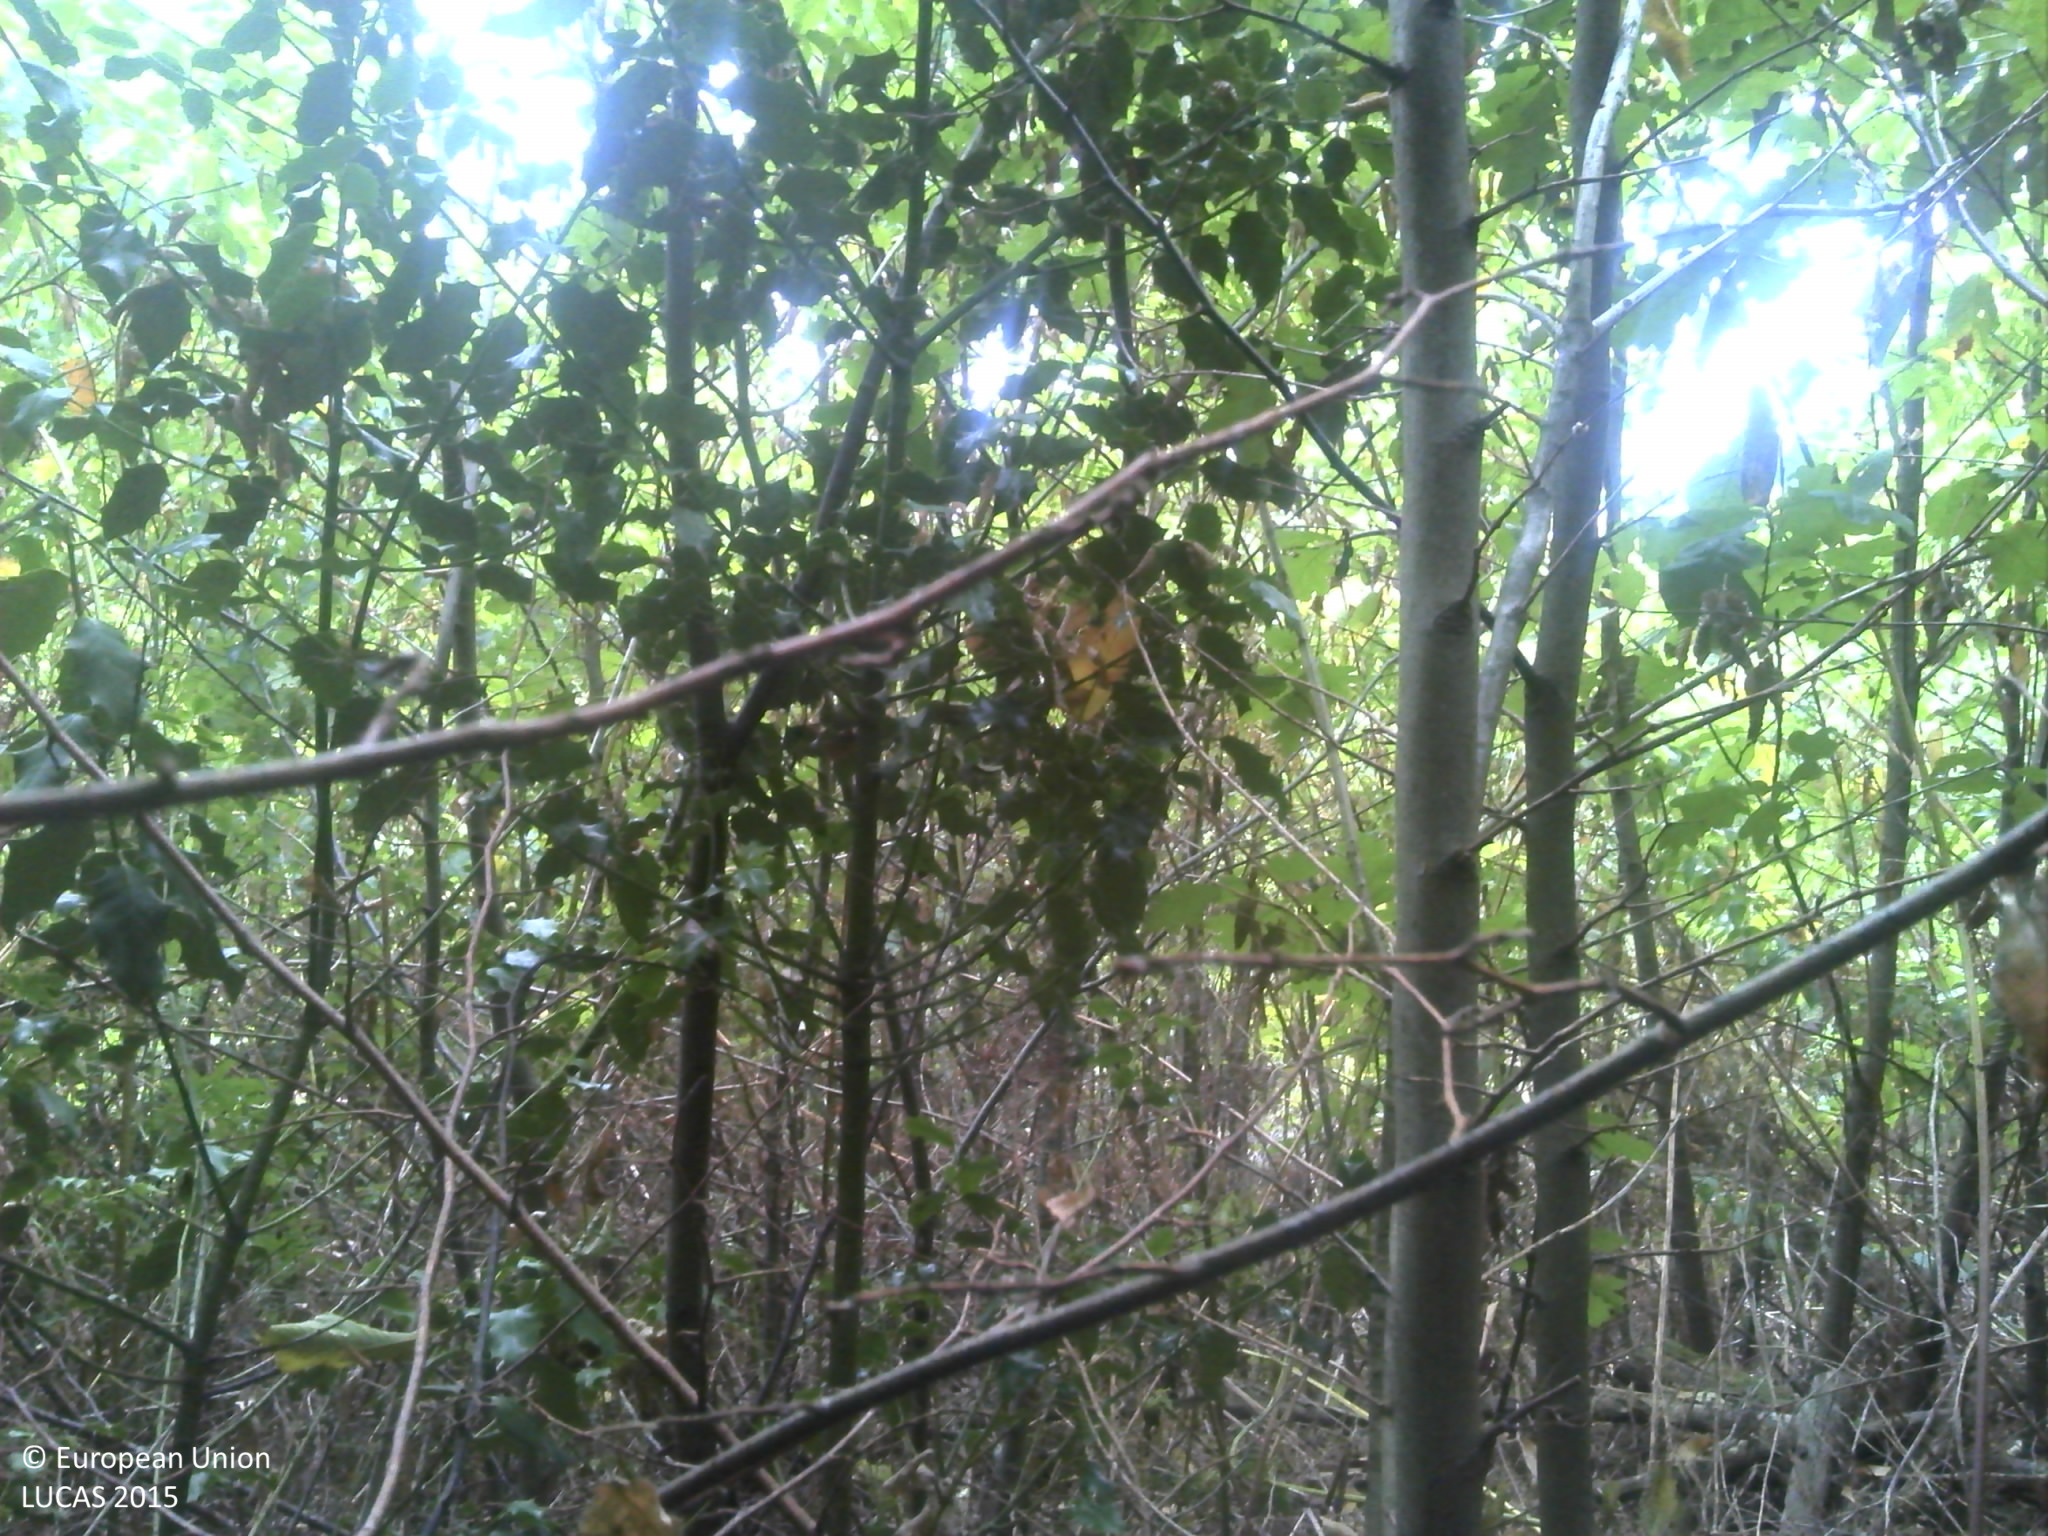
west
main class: Woodland
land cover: Broadleaved woodland
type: acidophilous oak and oak-birch forest
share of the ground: > 75 %
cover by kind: broadleaved forest trees 60 %, unconsolidated bare surface 30 %, herbaceous plants 5 %, lichens and mosses 5 %
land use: Semi-natural and natural areas not in use
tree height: > 5 m
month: July
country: FR
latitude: 45.0269
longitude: 1.8621
